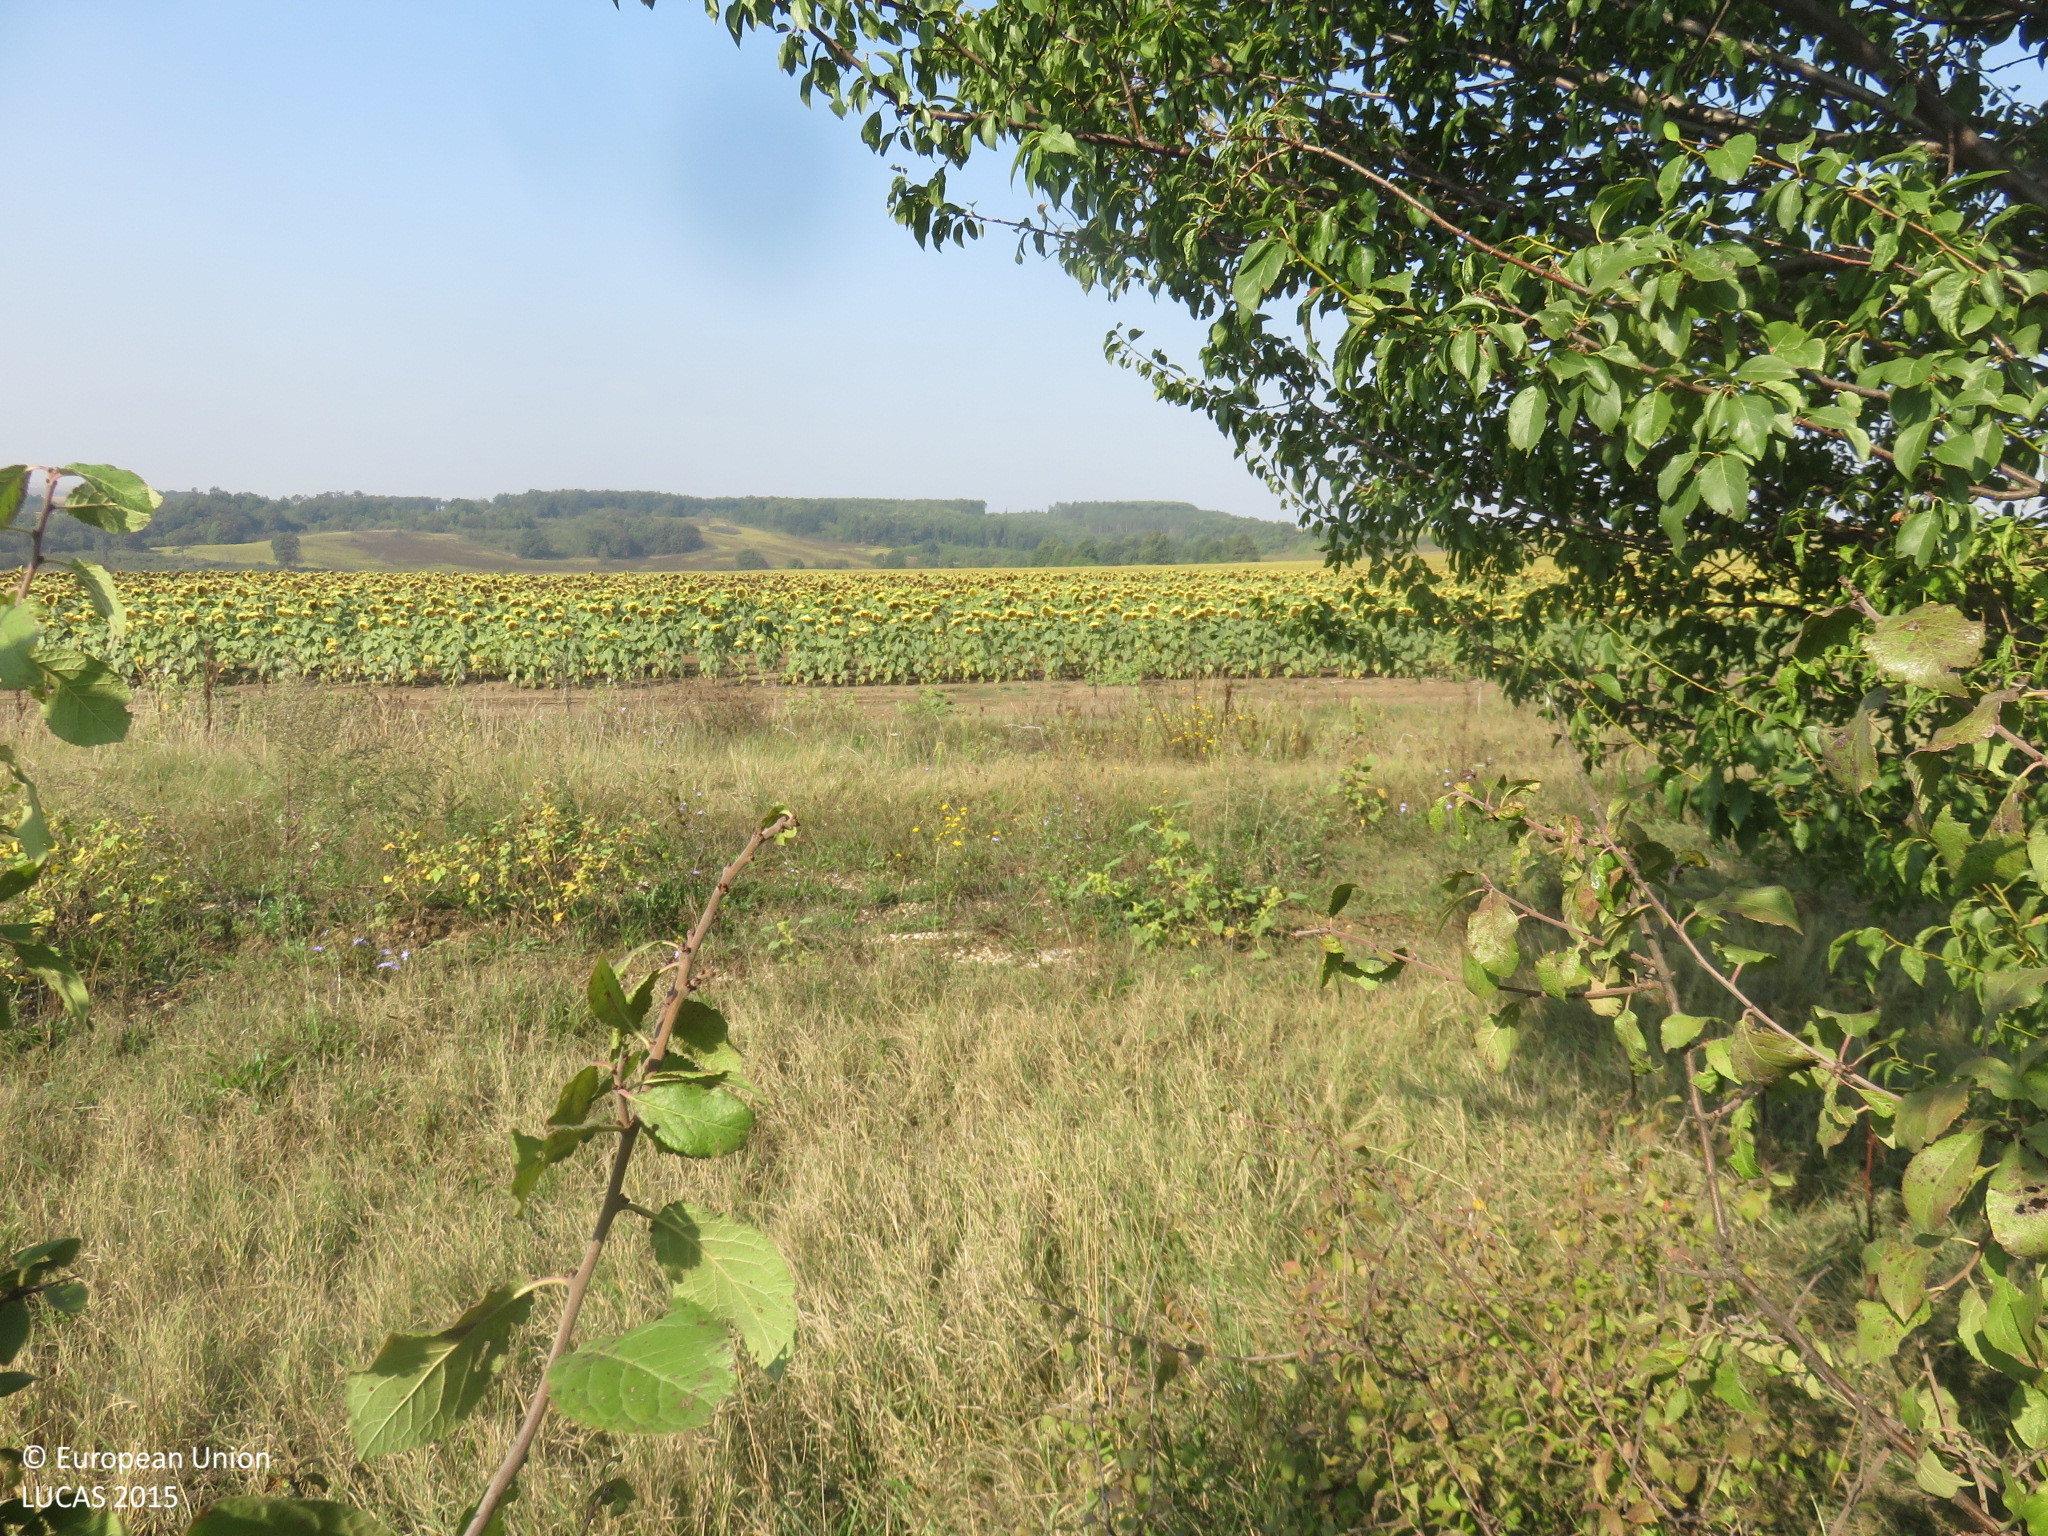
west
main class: Shrubland
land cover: Shrubland with sparse tree cover
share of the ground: > 75 %
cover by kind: shrubs 95 %, broadleaved forest trees 5 %
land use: Semi-natural and natural areas not in use
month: September
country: BG
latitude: 43.1633
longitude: 24.9865
